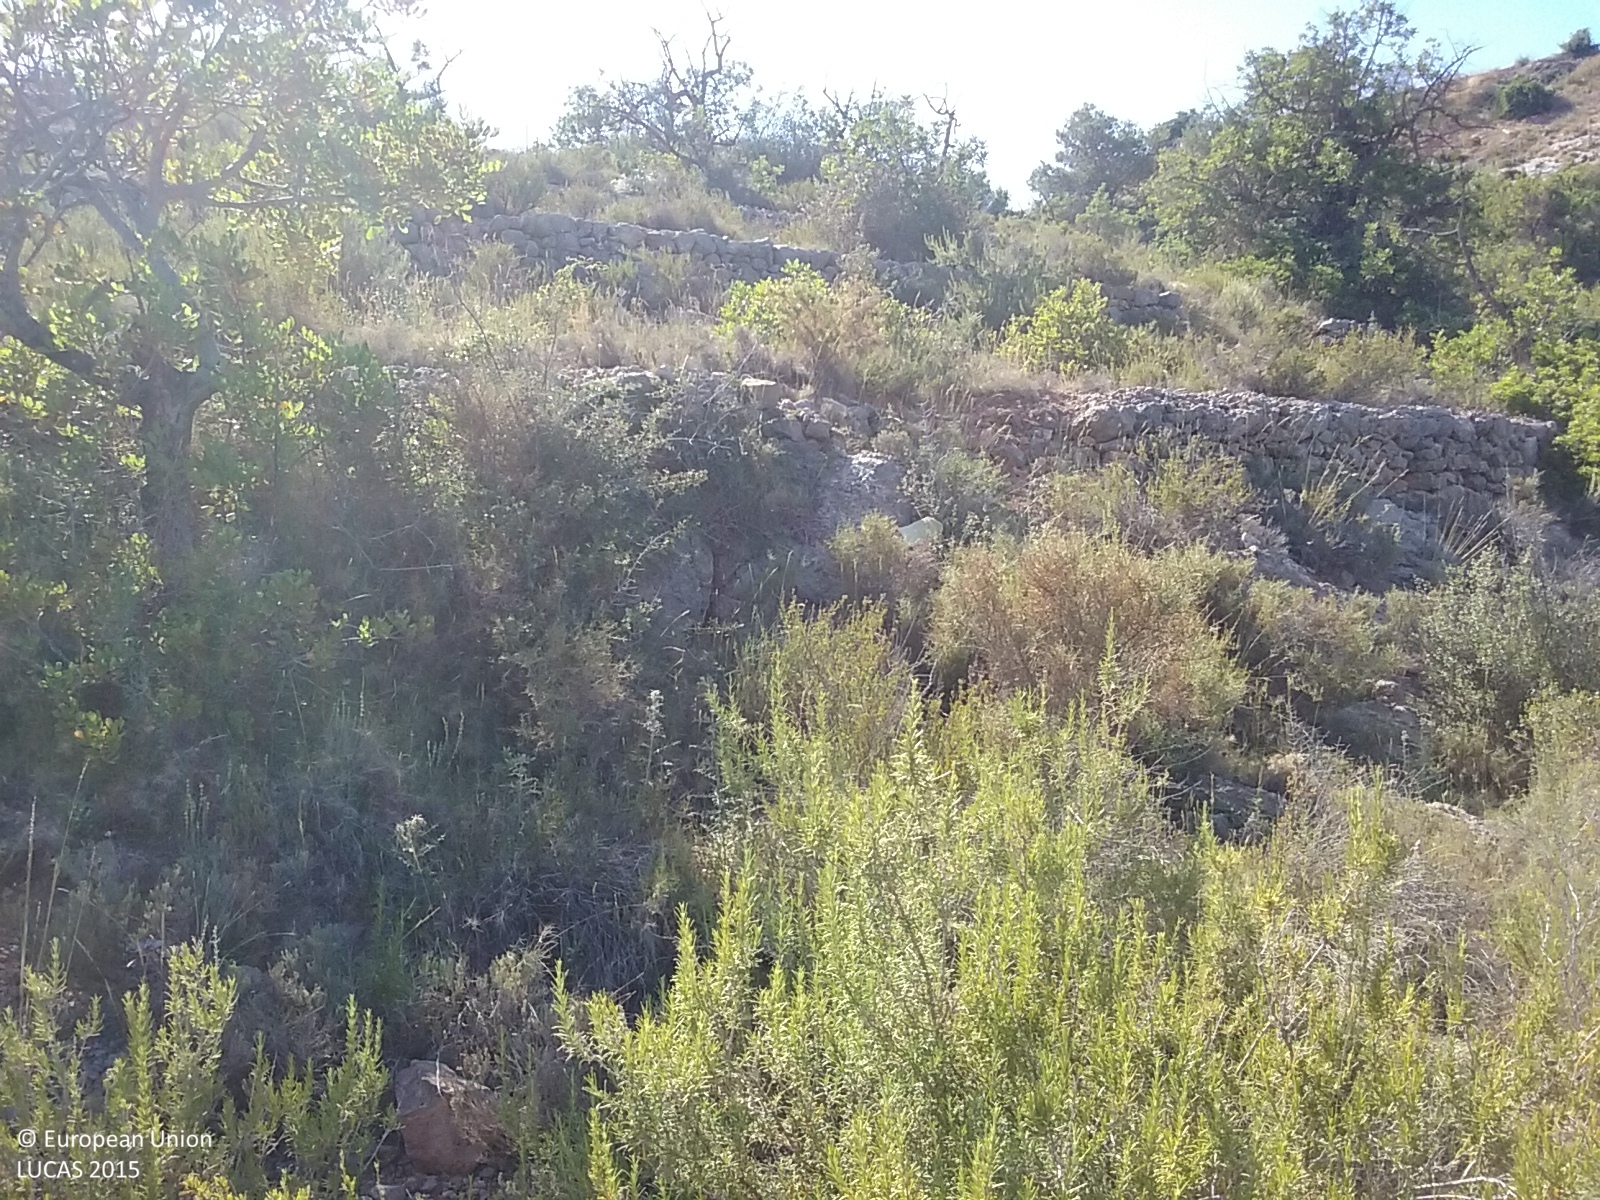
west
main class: Cropland
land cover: Permanent industrial crops
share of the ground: < 10 %
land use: Abandoned areas
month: June
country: ES
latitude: 40.0240
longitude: -0.0432
